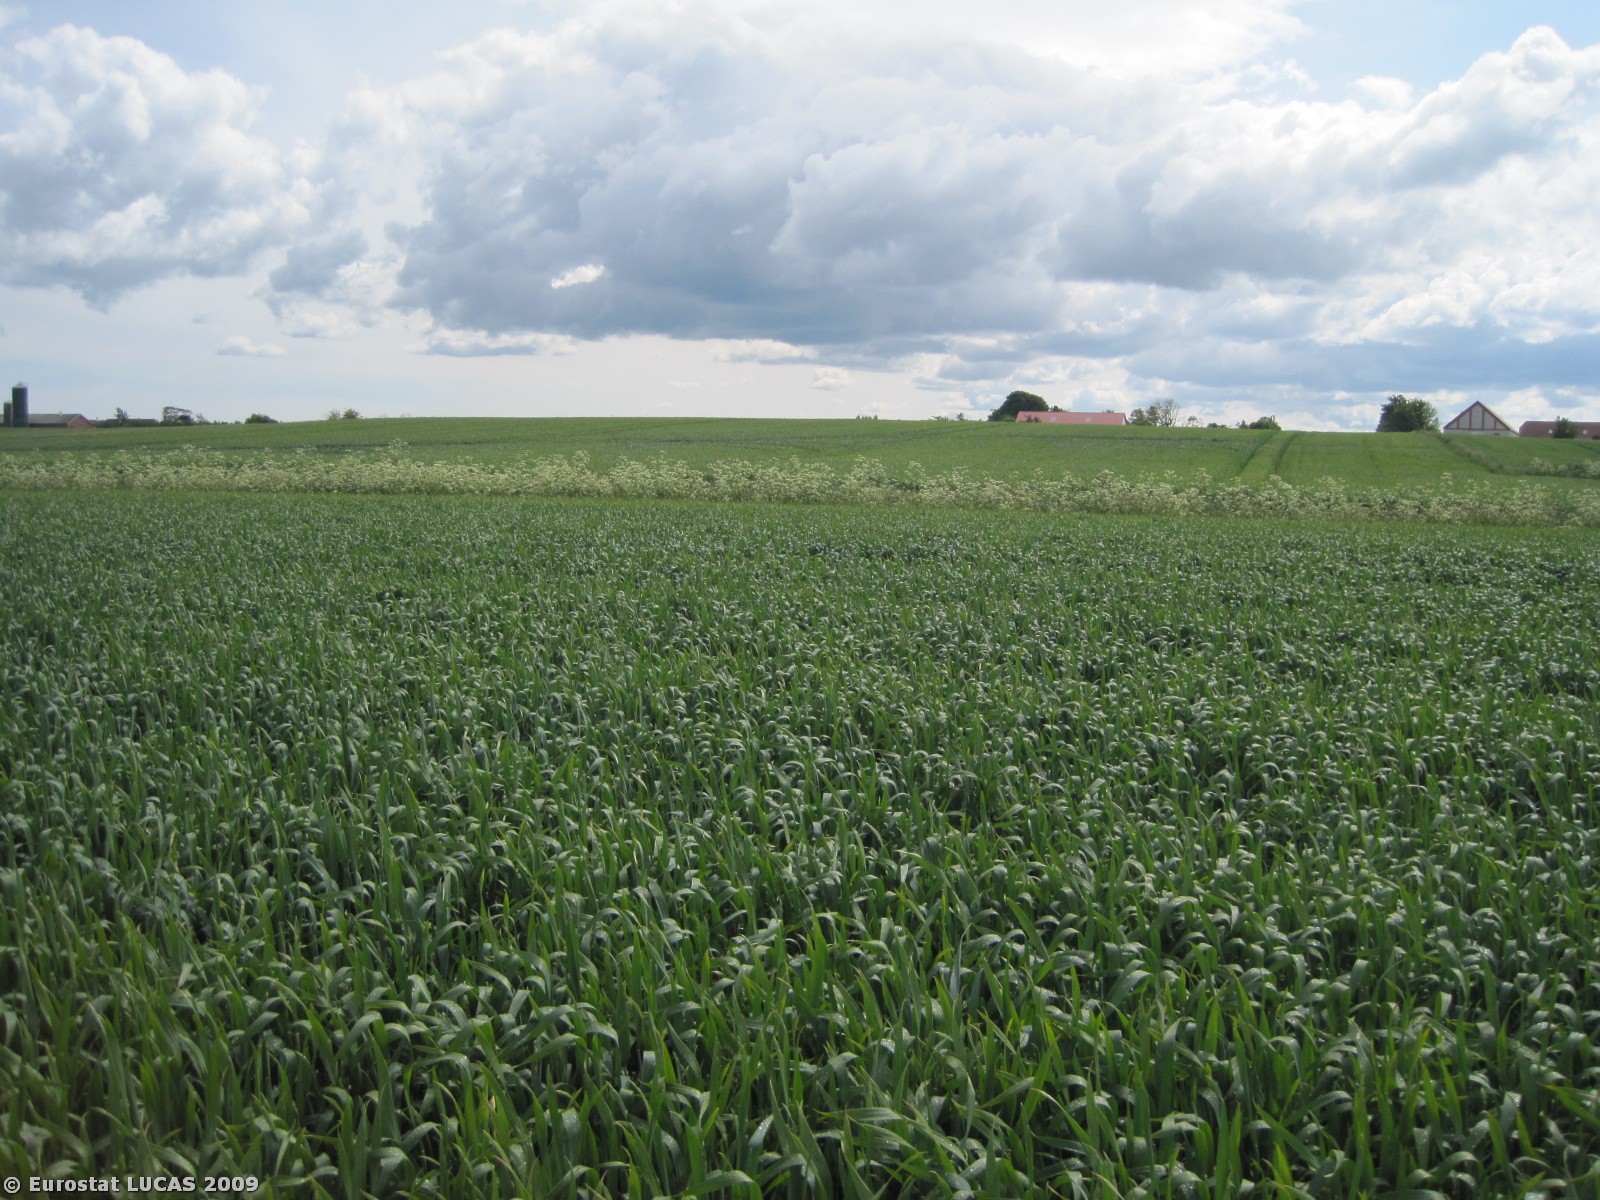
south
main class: Cropland
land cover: Common wheat
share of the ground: > 75 %
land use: Agriculture (excluding fallow land and kitchen gardens)
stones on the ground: < 10 %
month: June
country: DK
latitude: 57.3203
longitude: 9.8840
